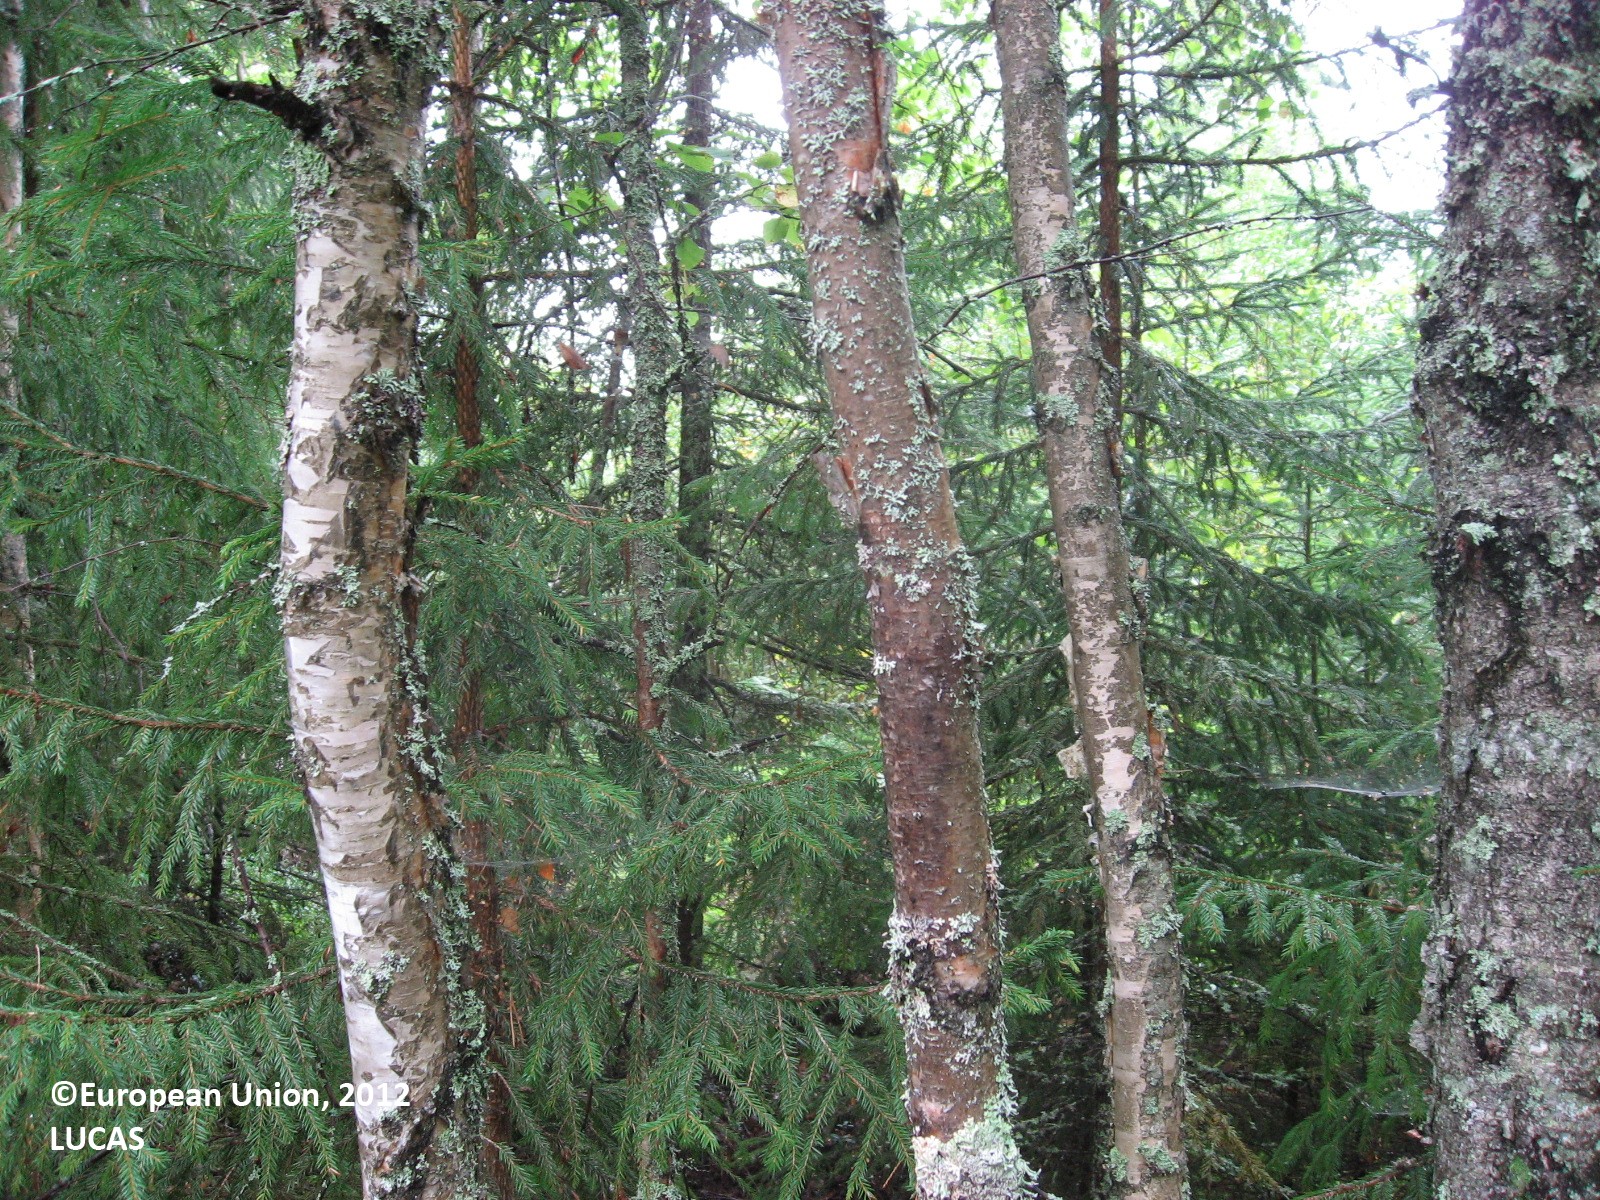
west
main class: Woodland
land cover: Spruce dominated mixed woodland
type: boreal forest
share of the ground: > 75 %
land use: Forestry
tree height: > 5 m
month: August
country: FI
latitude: 61.1080
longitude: 24.7460
